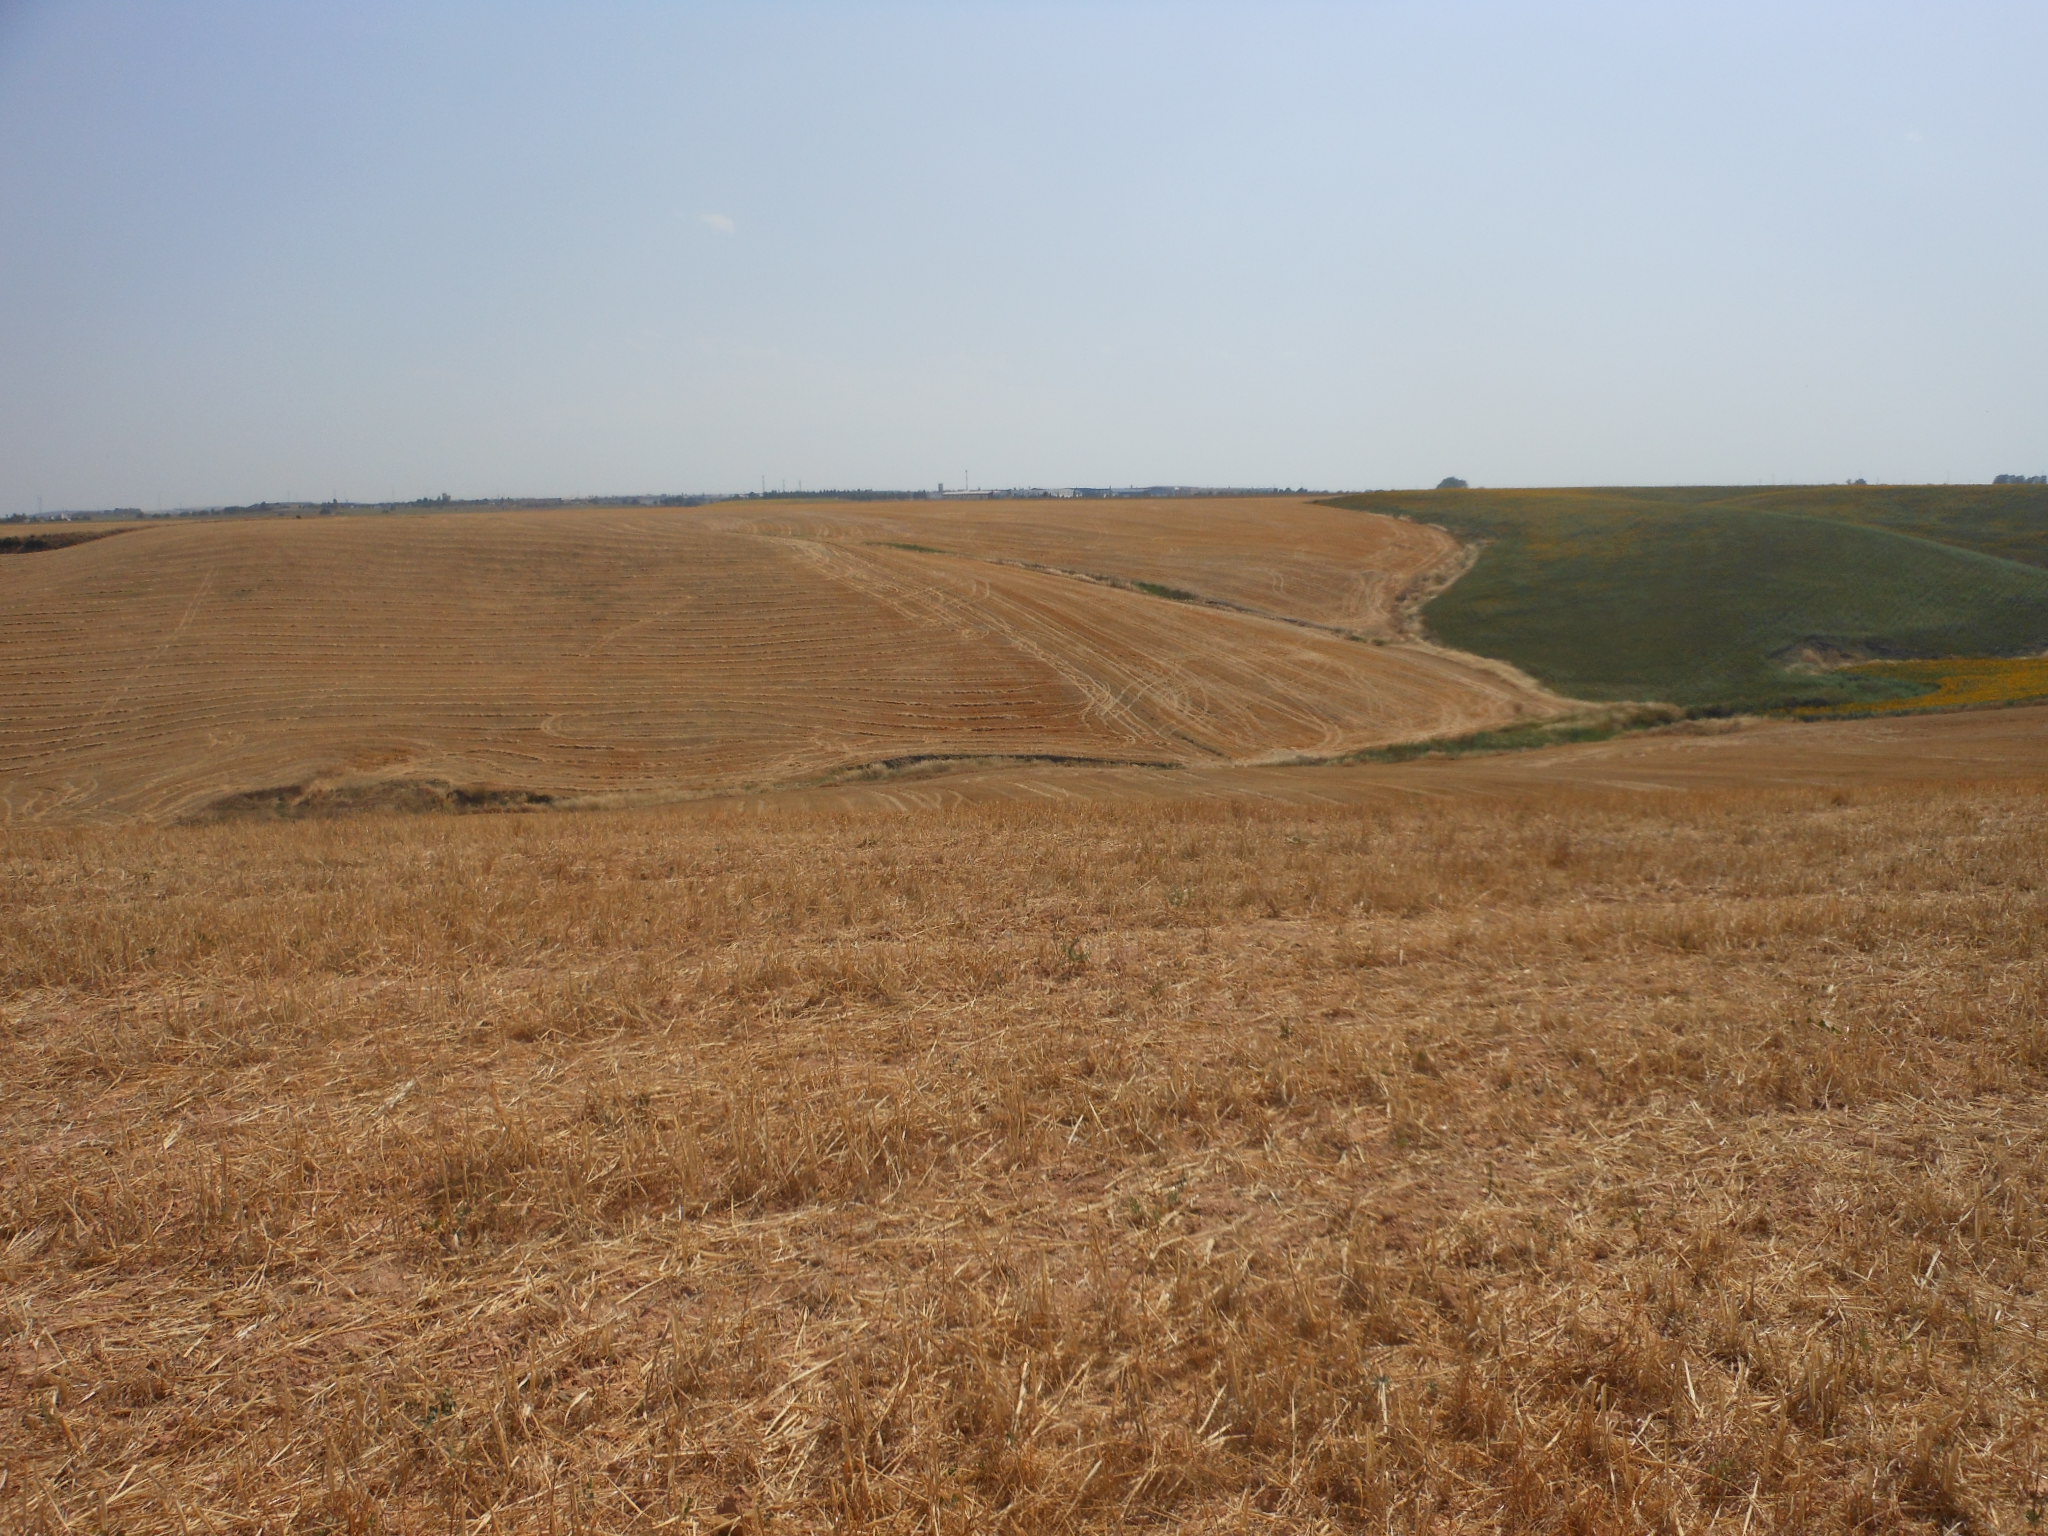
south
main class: Cropland
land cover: Durum wheat
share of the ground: < 10 %
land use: Agriculture (excluding fallow land and kitchen gardens)
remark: Harvested field
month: June
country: ES
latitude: 37.5465
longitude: -5.1006
